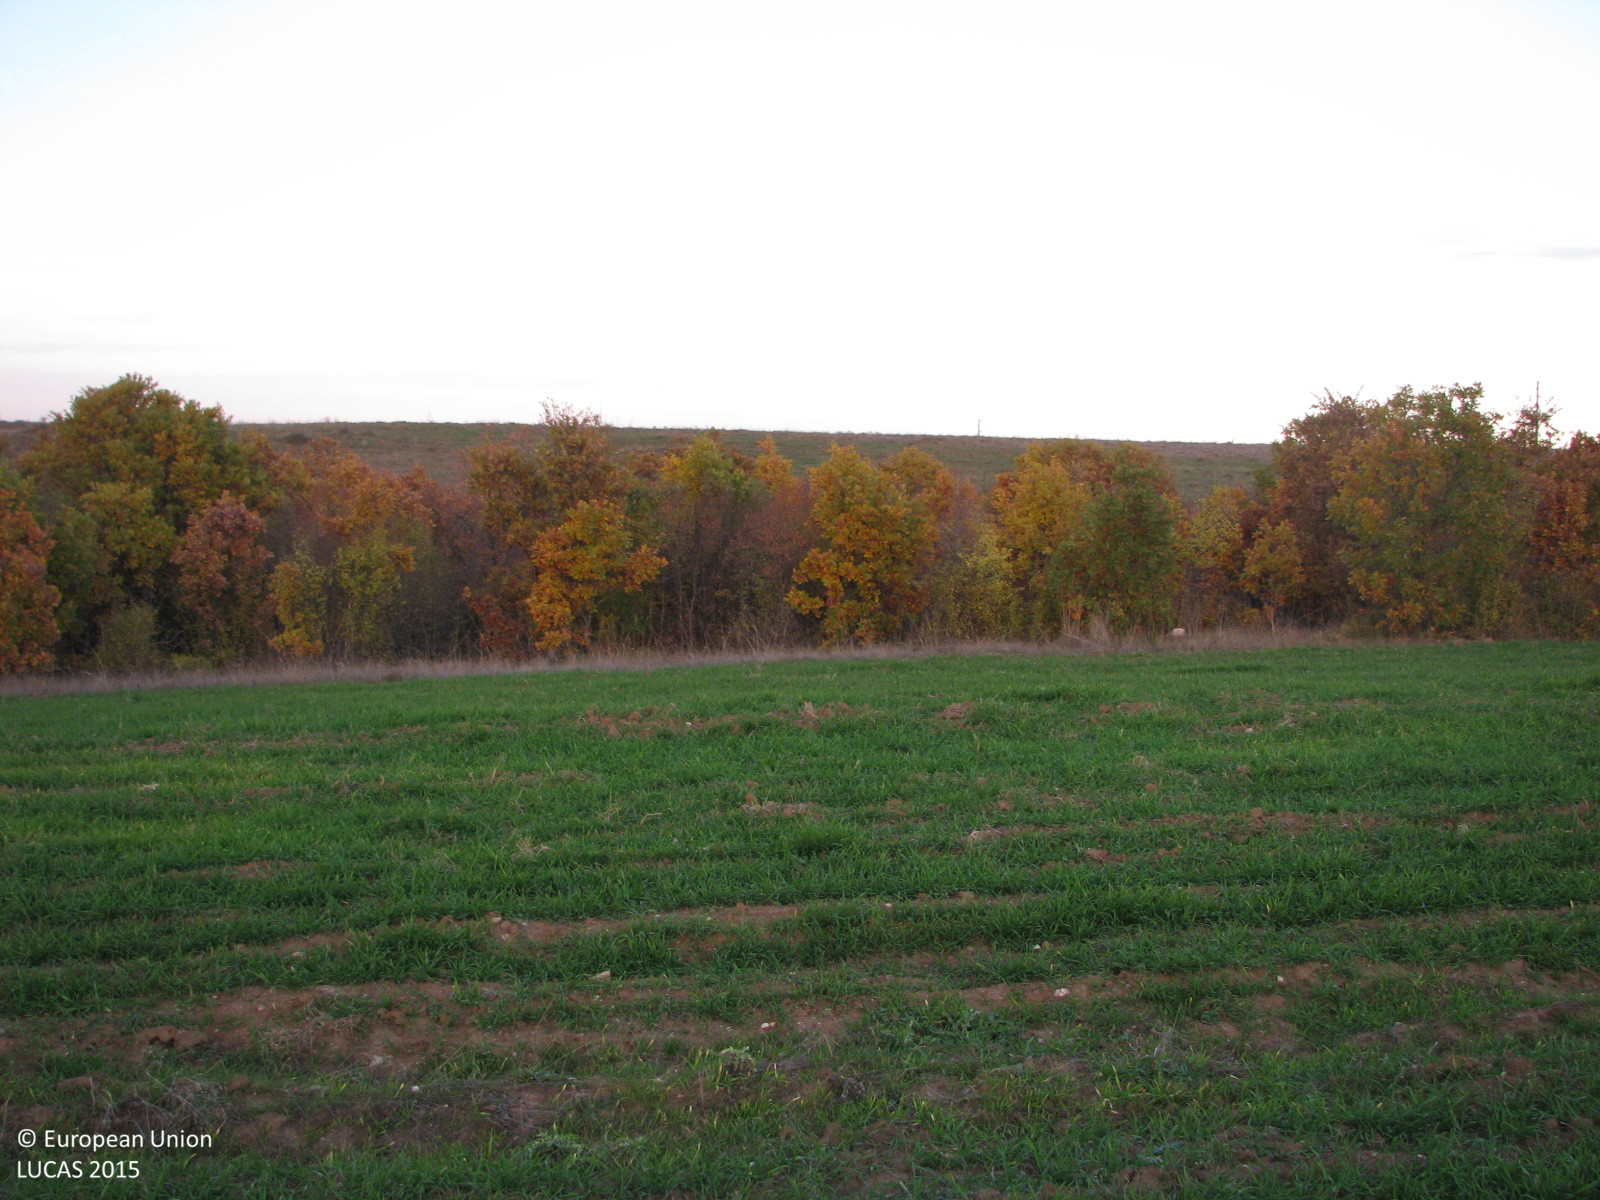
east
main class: Cropland
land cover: Common wheat
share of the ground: 50 - 75 %
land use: Agriculture (excluding fallow land and kitchen gardens)
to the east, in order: Common wheat; Broadleaved woodland; Rivers and streams; Broadleaved woodland; Grassland without tree/shrub cover; Electric lines; Grassland without tree/shrub cover; Tracks; Grassland without tree/shrub cover
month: November
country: BG
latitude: 41.9280
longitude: 26.4232
